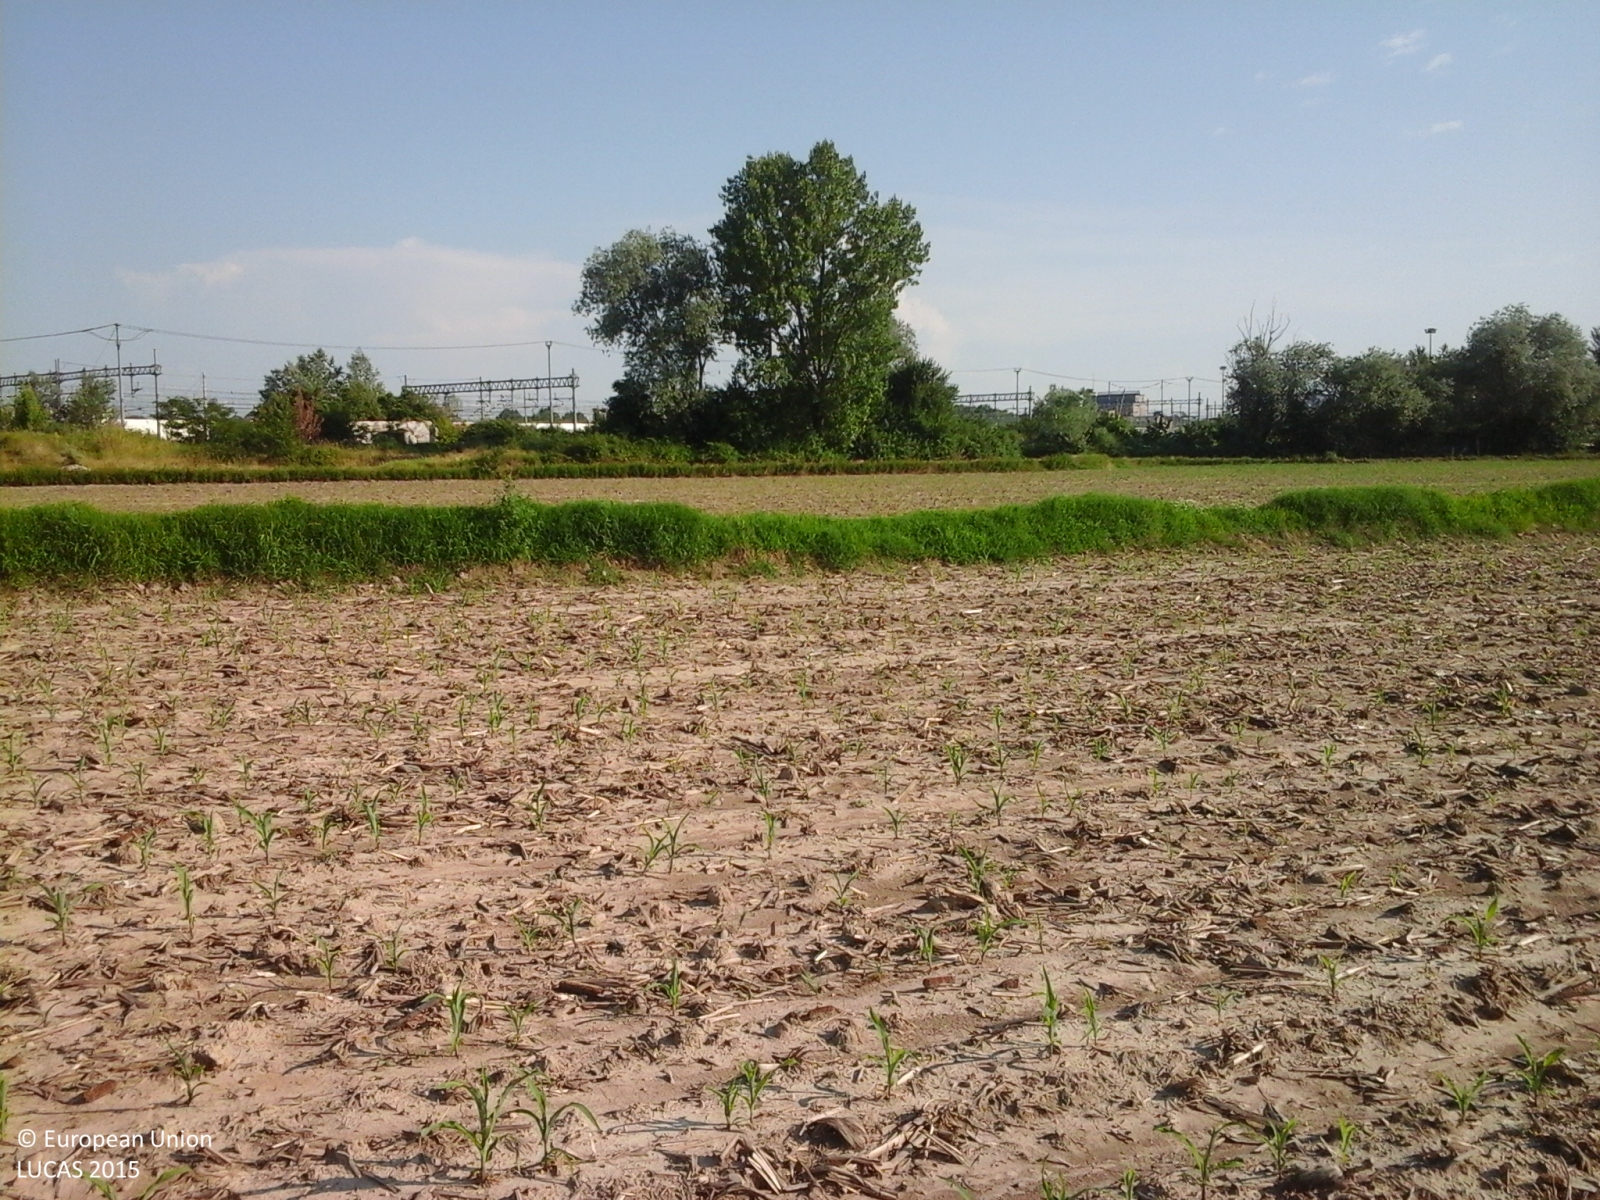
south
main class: Cropland
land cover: Maize
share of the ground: 10 - 25 %
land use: Agriculture (excluding fallow land and kitchen gardens)
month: June
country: IT
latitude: 45.4595
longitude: 8.6339
